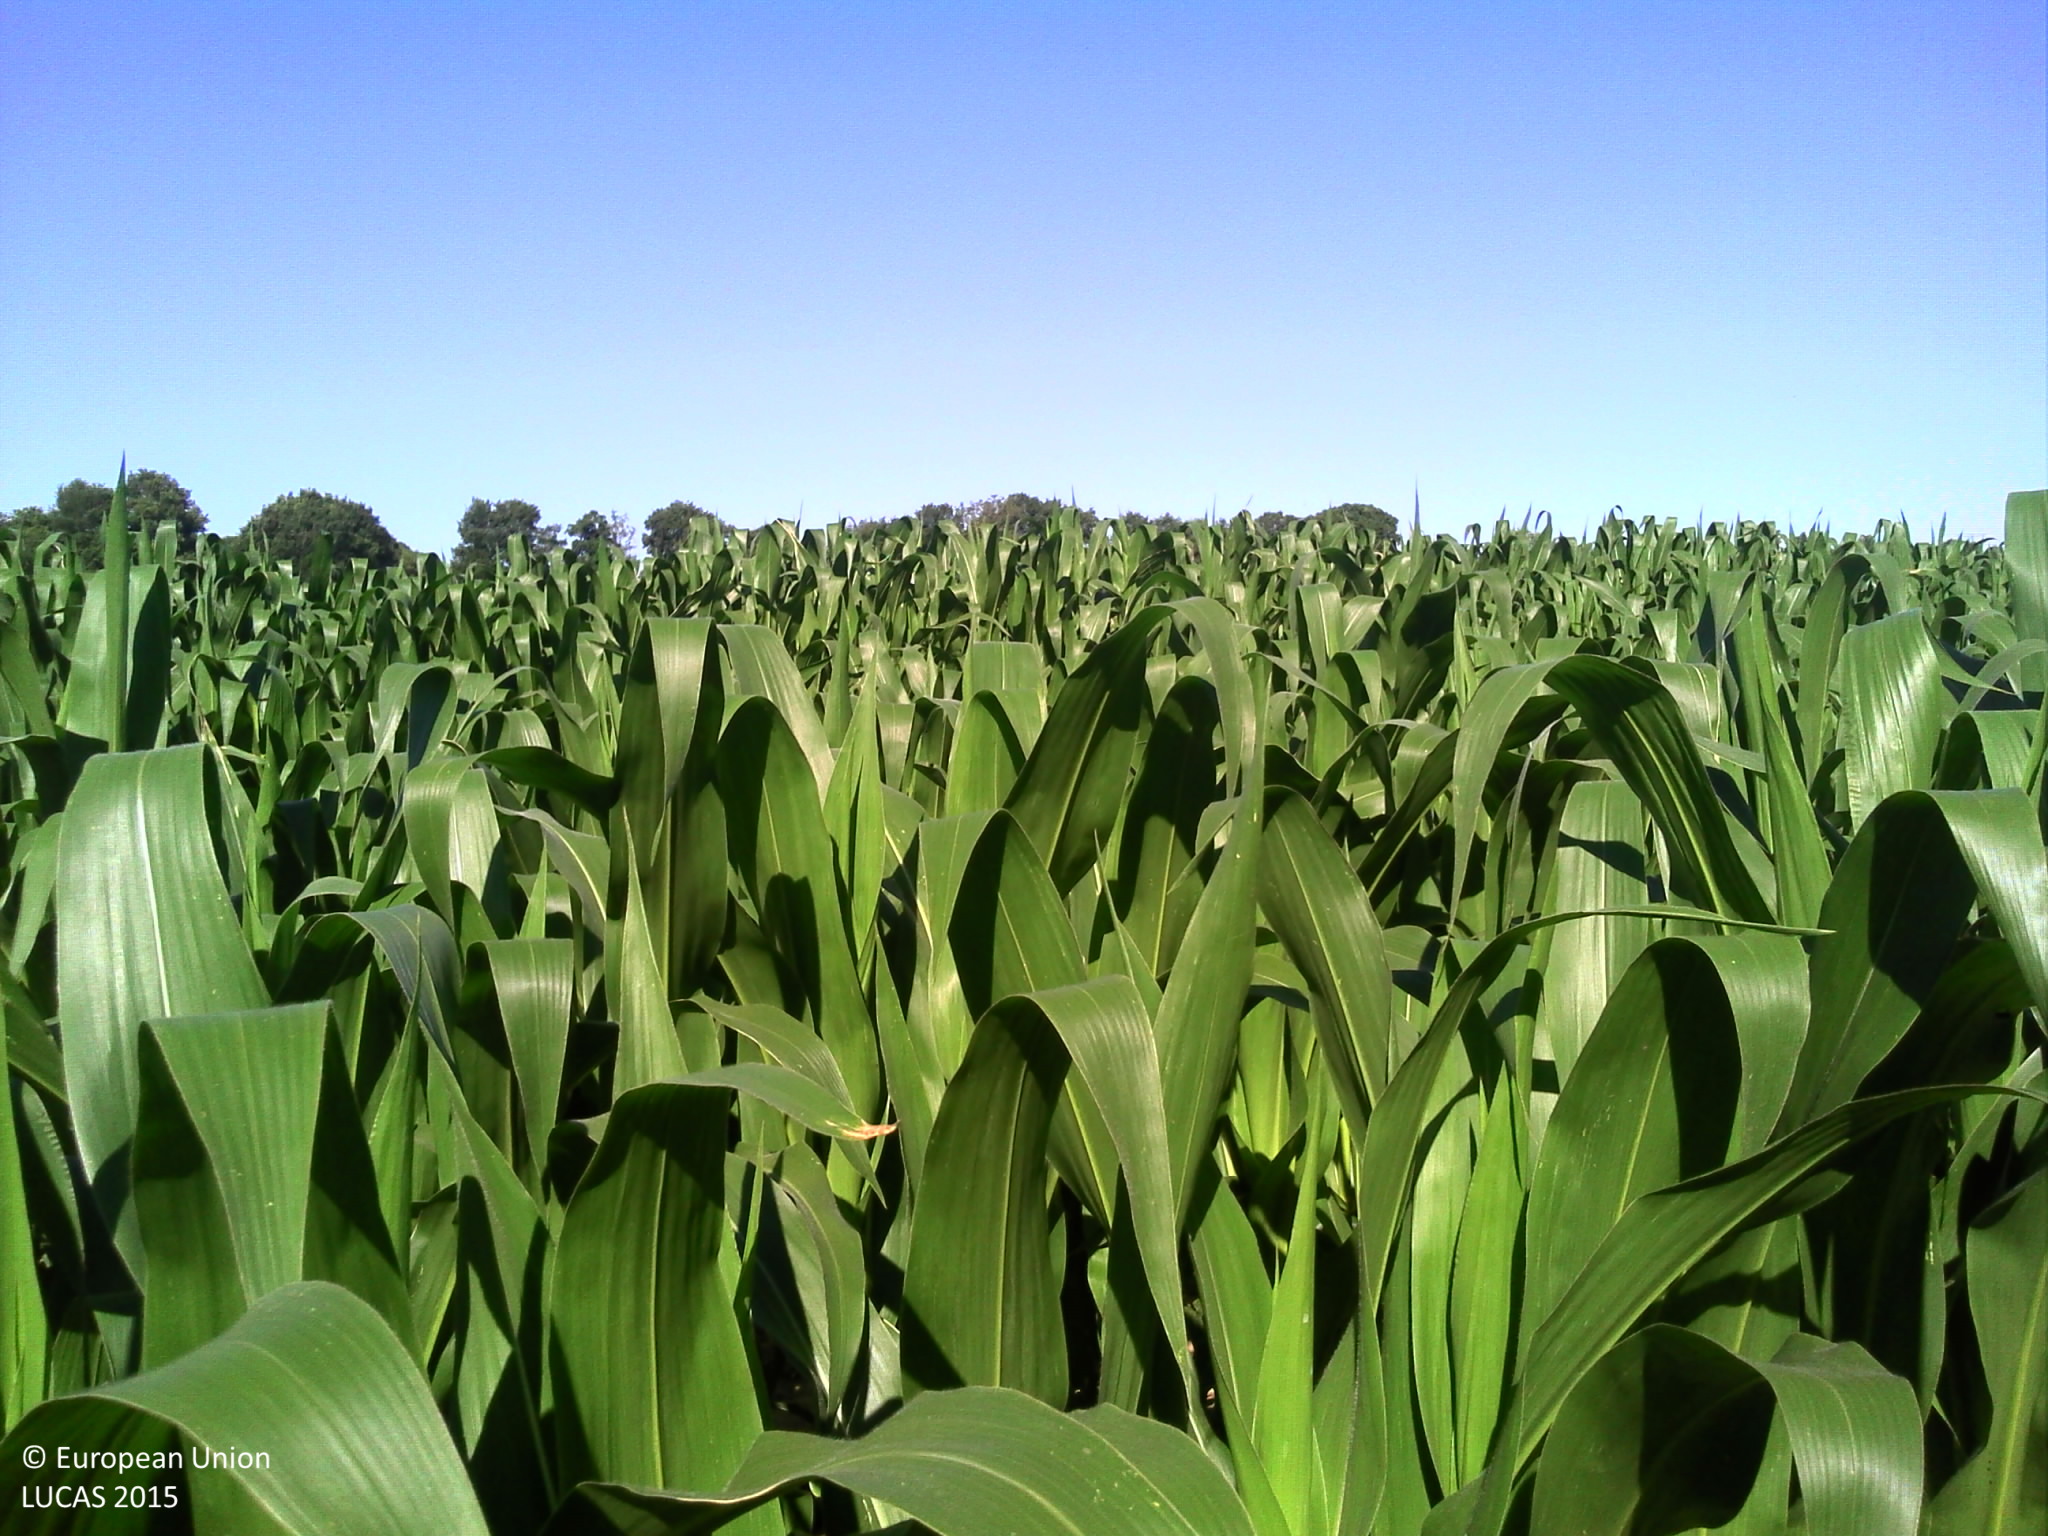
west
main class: Cropland
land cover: Maize
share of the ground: > 75 %
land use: Agriculture (excluding fallow land and kitchen gardens)
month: June
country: FR
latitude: 46.4484
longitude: 0.8600
